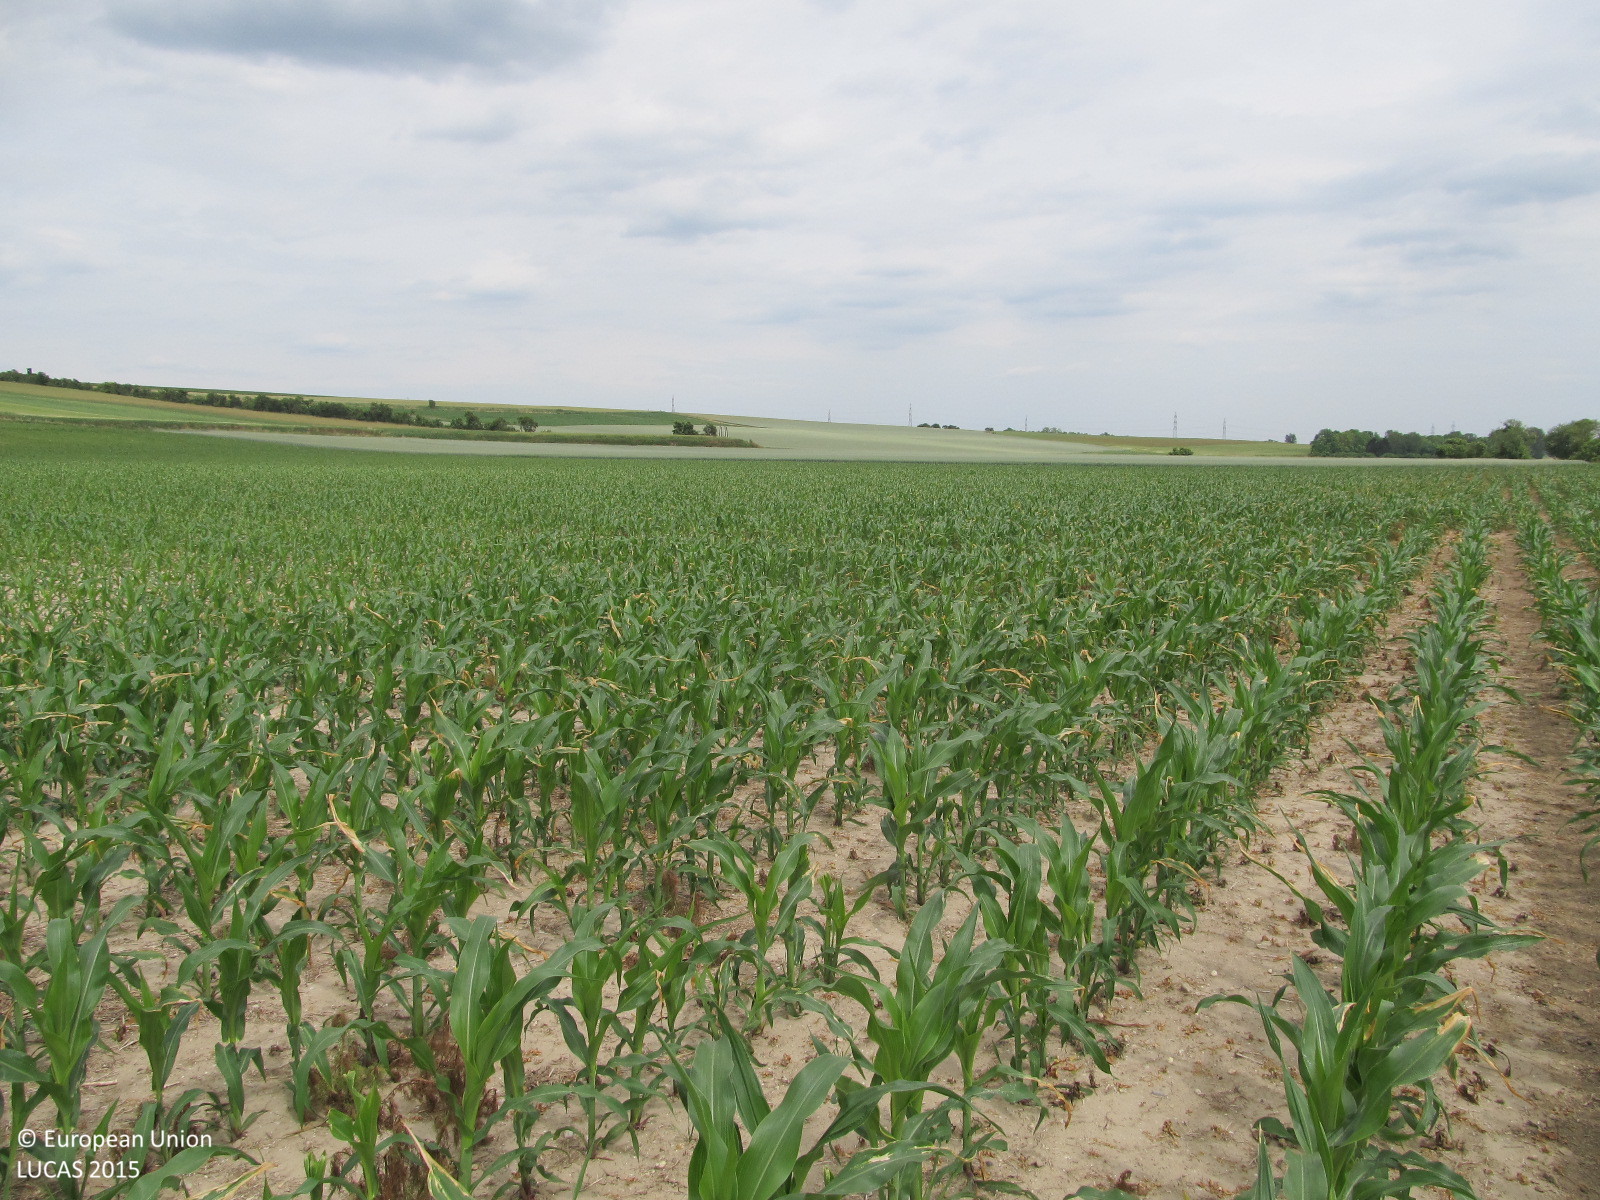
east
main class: Cropland
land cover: Maize
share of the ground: 25 - 50 %
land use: Agriculture (excluding fallow land and kitchen gardens)
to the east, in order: Maize; Common wheat
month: June
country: AT
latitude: 48.4646
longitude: 15.8598
